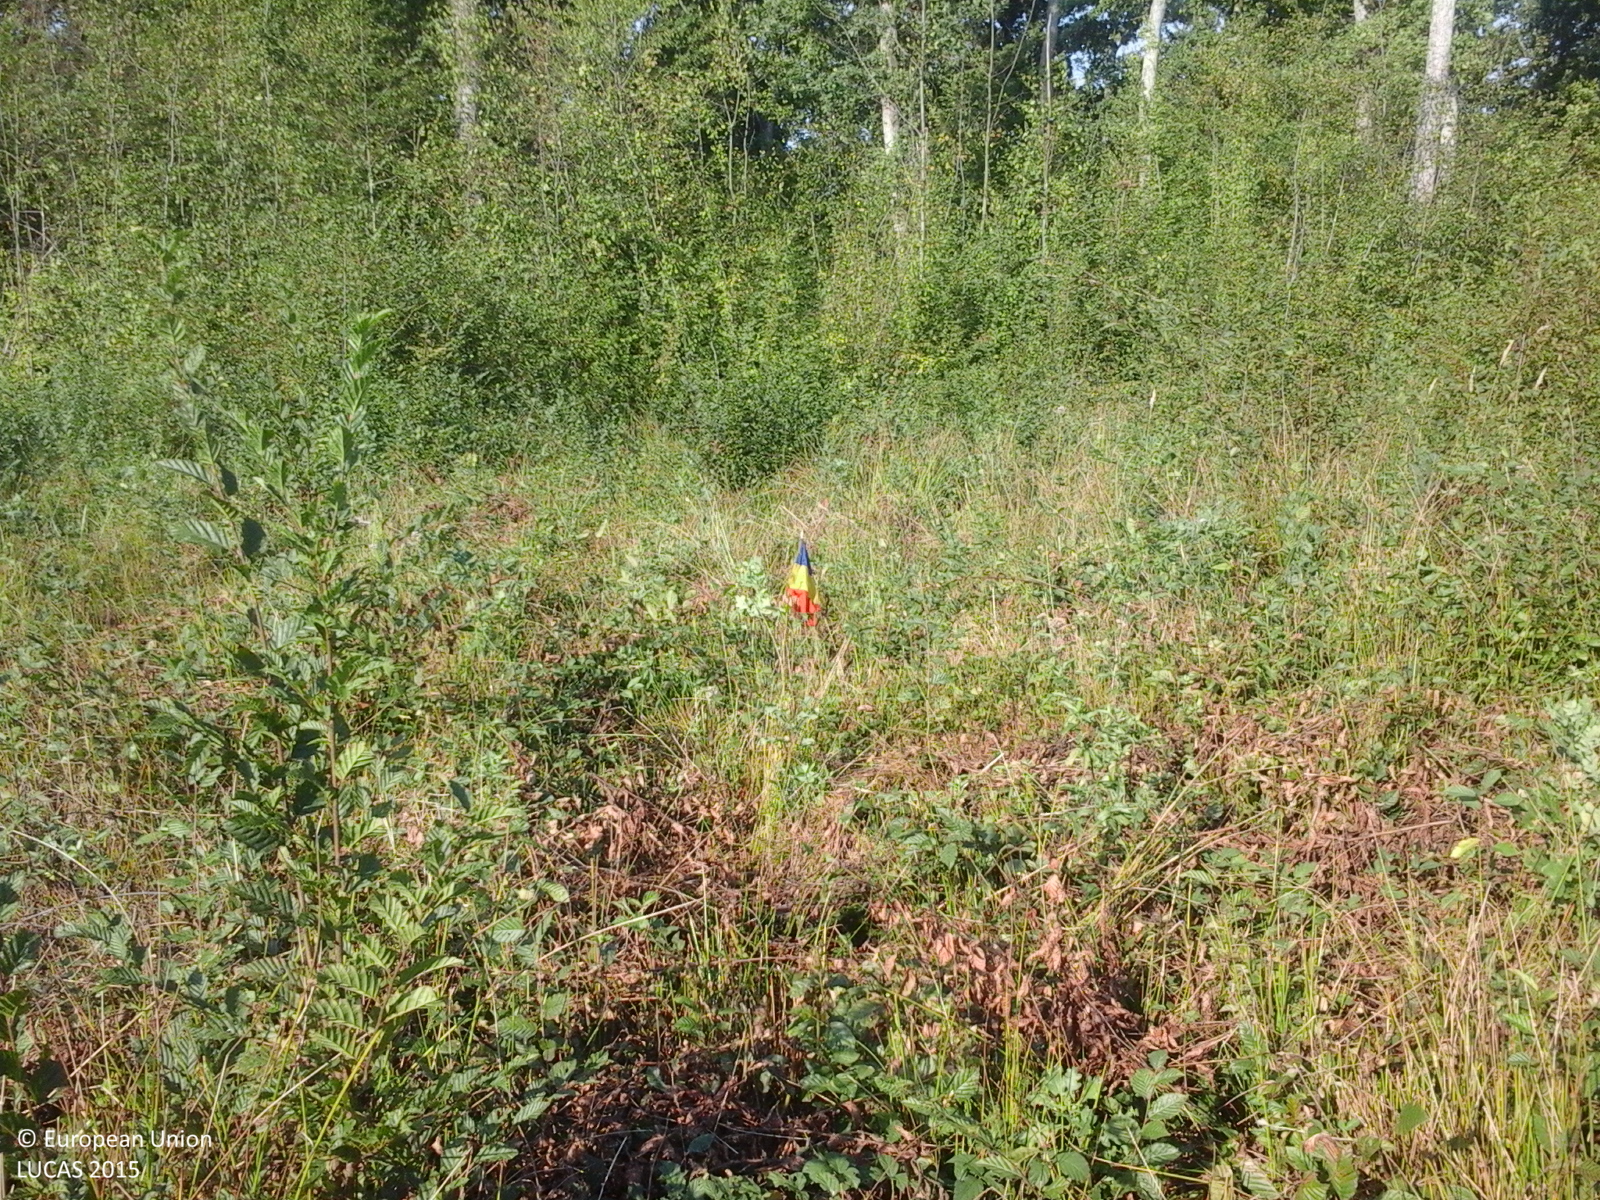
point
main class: Shrubland
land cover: Shrubland with sparse tree cover
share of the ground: > 75 %
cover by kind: herbaceous plants 75 %, shrubs 20 %, broadleaved forest trees 5 %
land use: Forestry
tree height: < 5 m
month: August
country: RO
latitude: 46.4192
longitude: 22.1593
